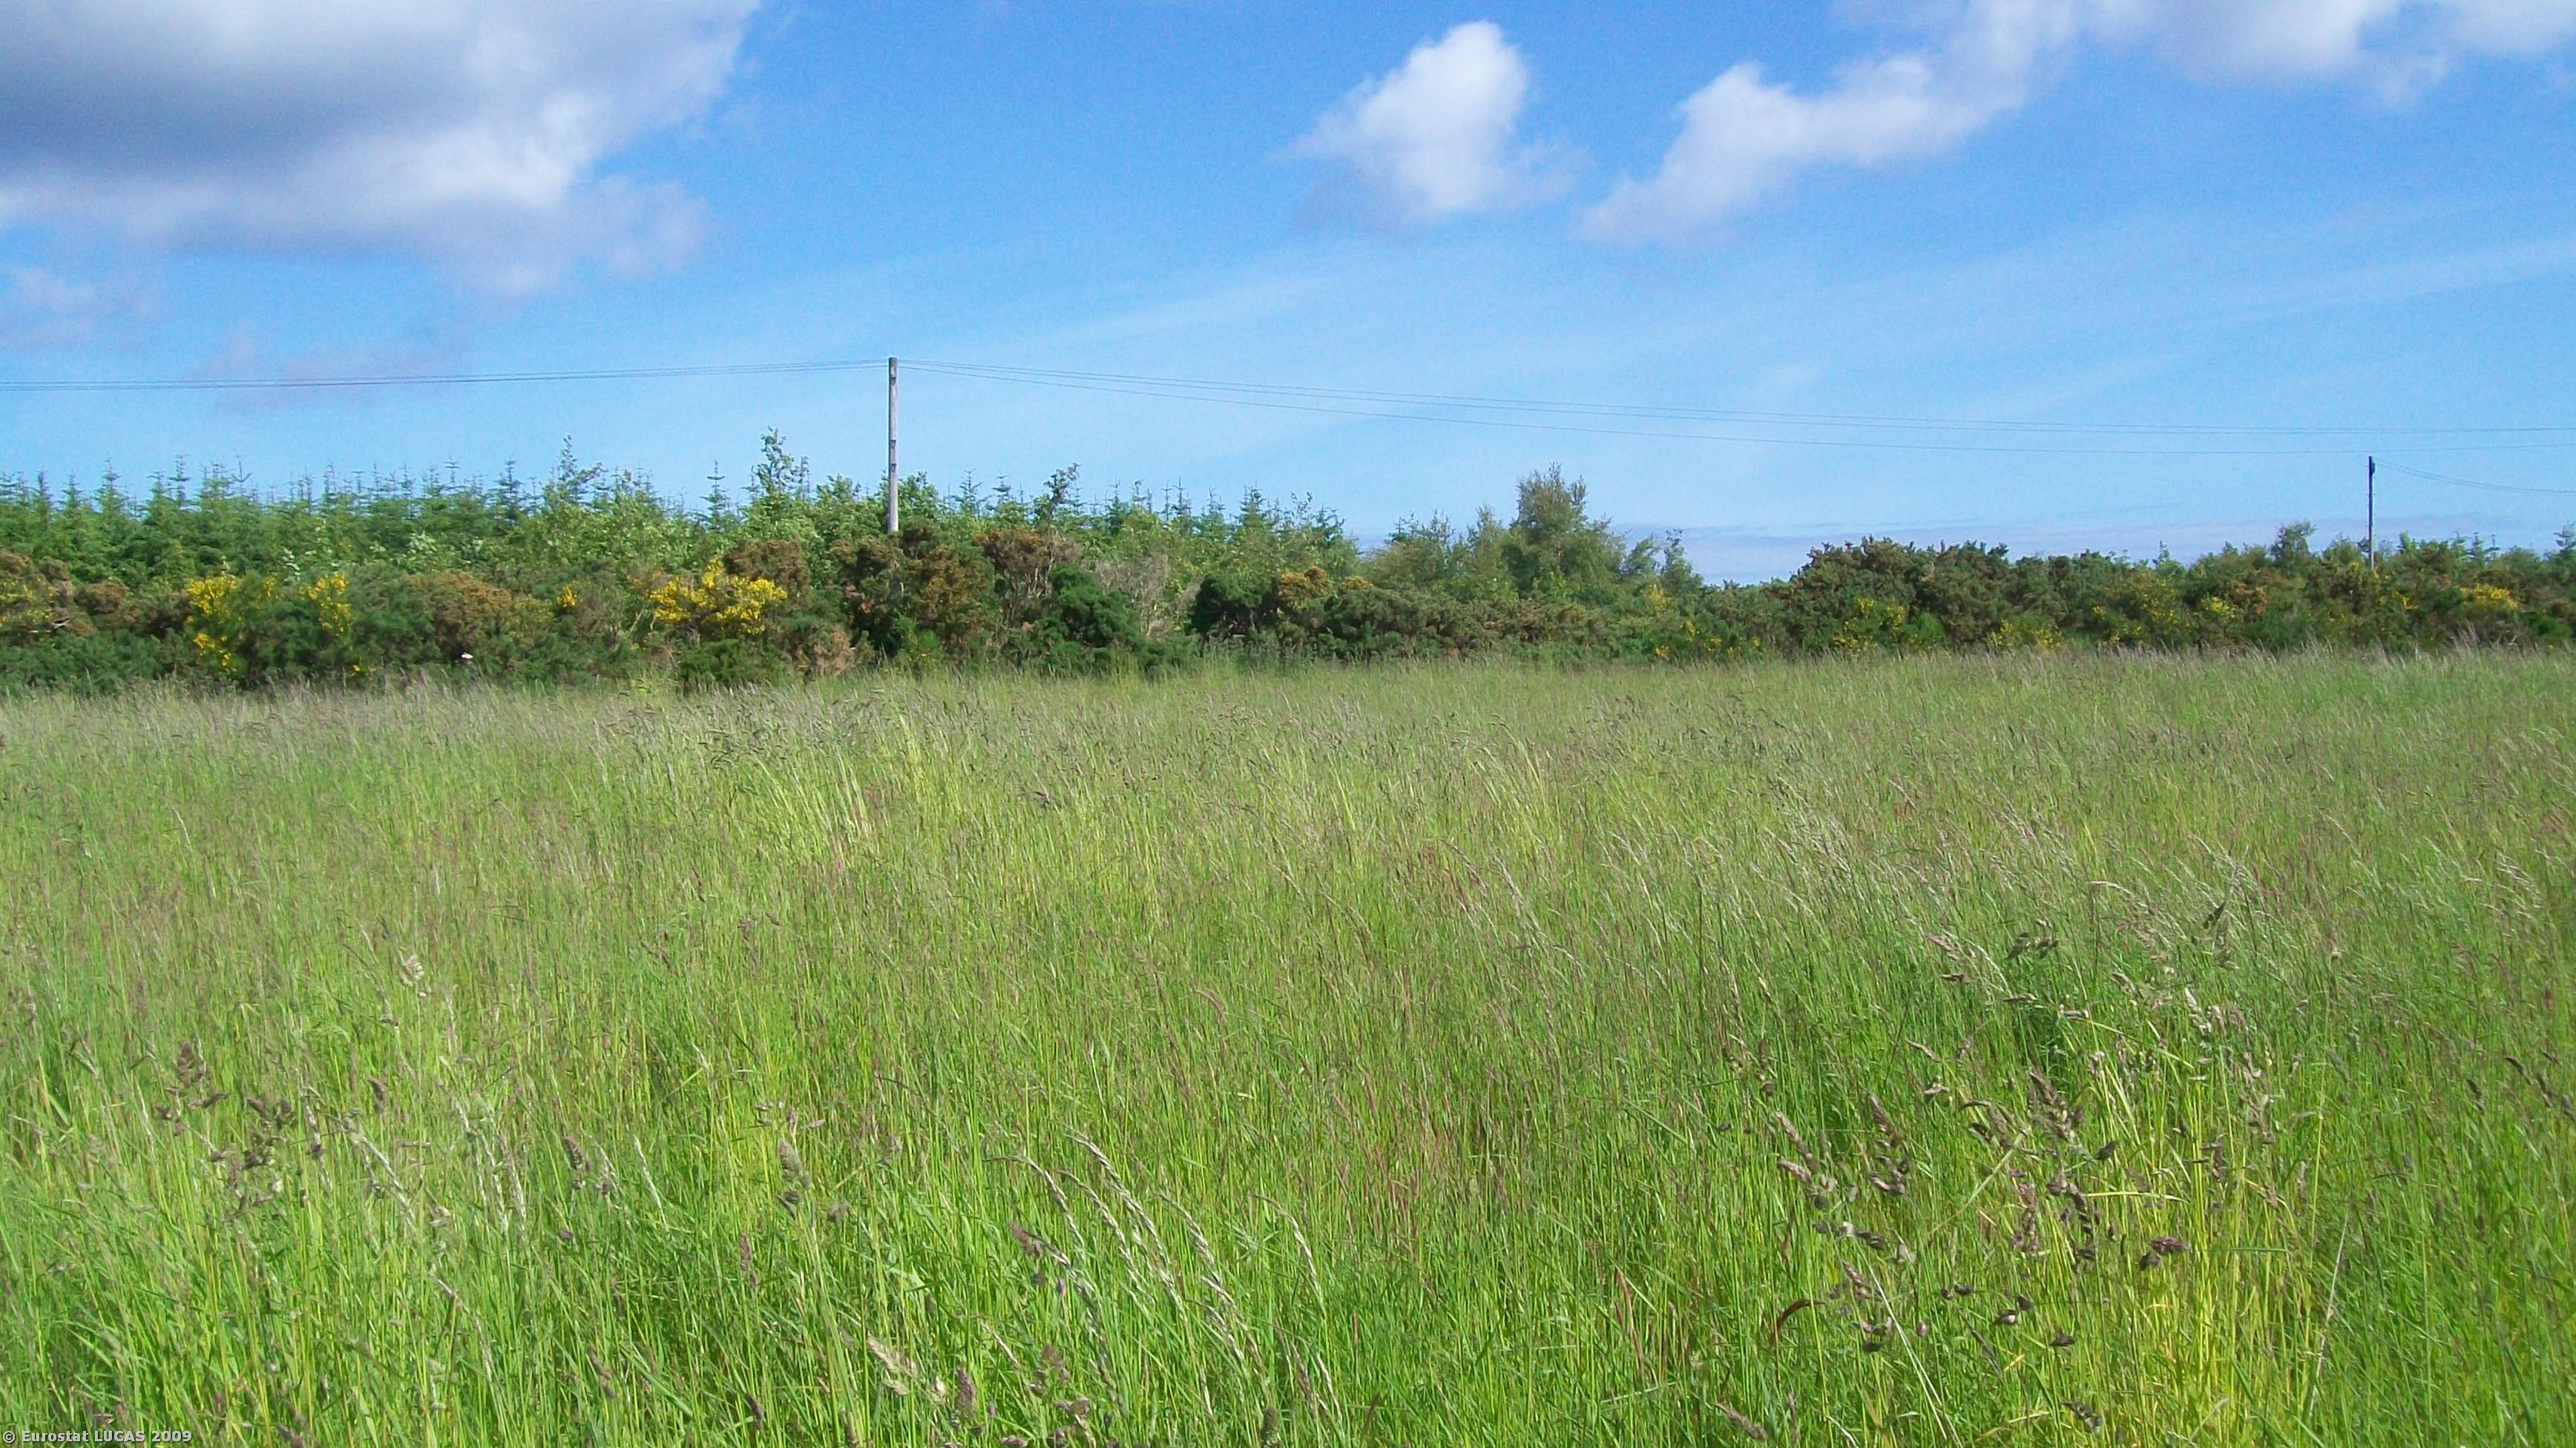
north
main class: Grassland
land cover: Grassland without tree/shrub cover
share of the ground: > 75 %
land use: Fallow land
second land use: Nature reserves
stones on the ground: 10 - 25 %
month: June
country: GB
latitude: 57.6867
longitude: -2.8896
